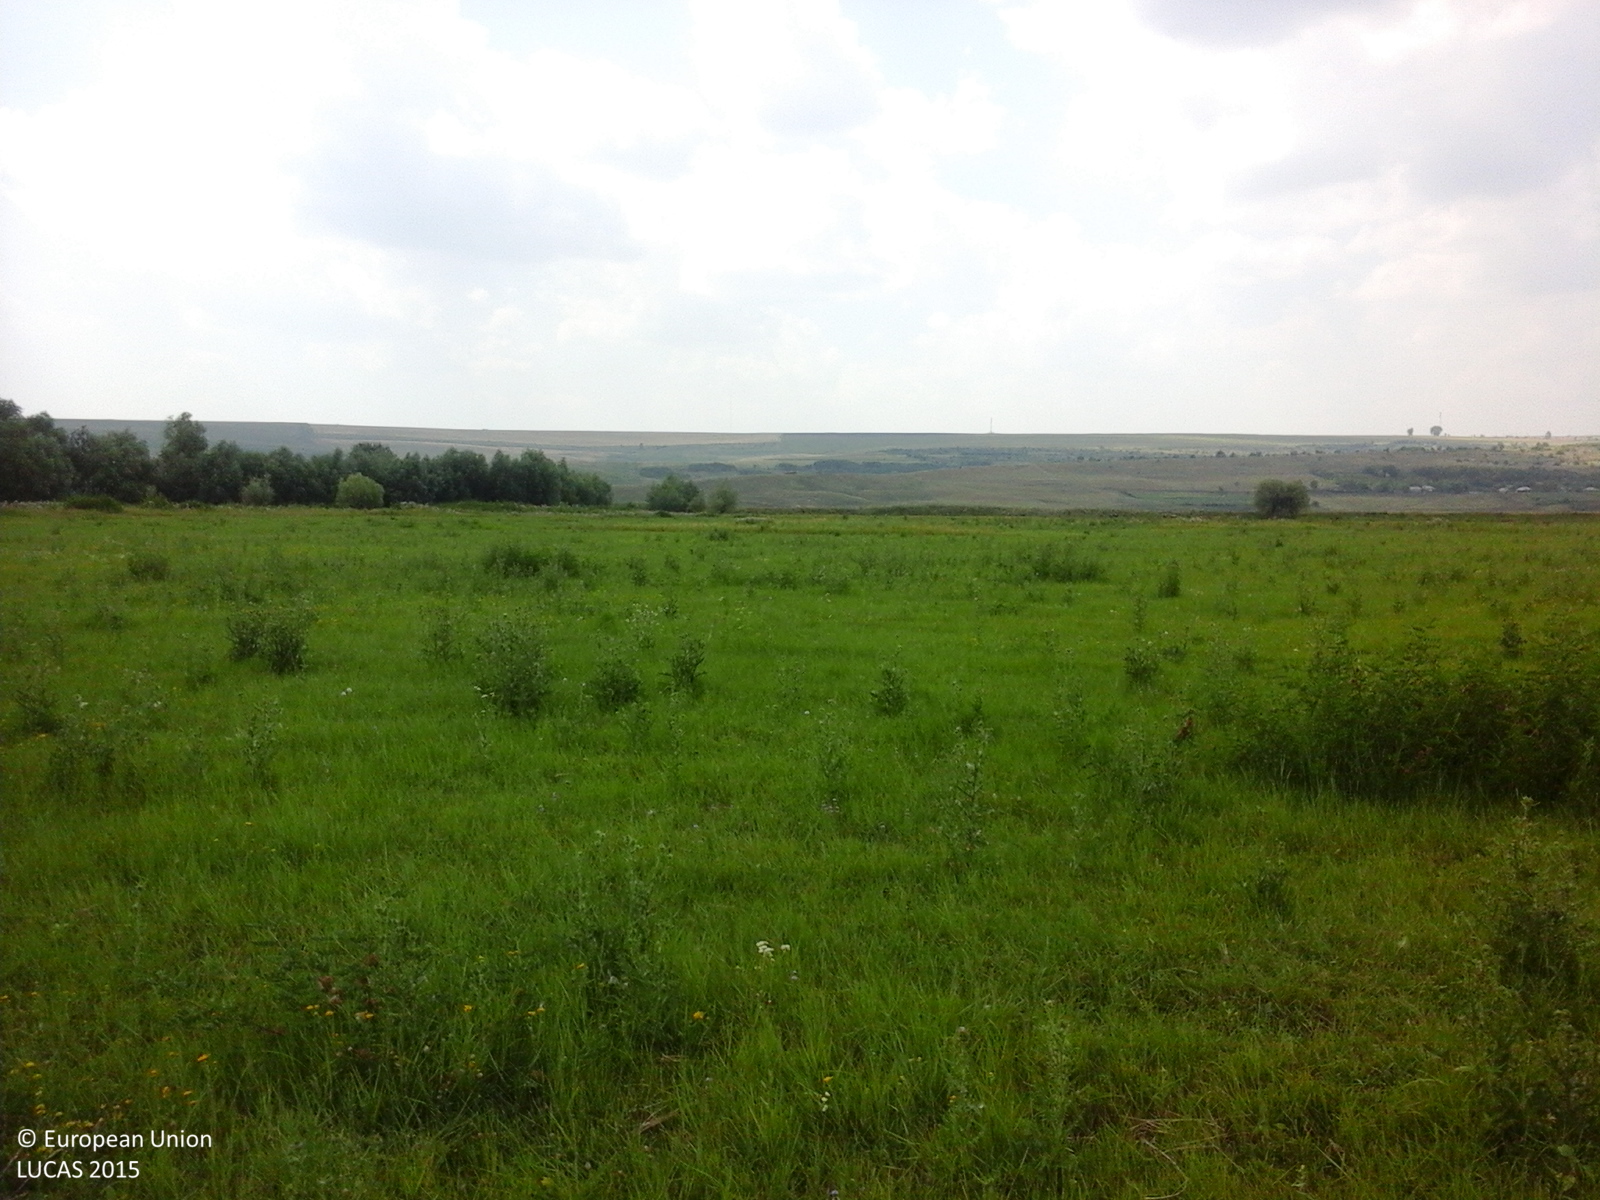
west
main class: Grassland
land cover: Spontaneously vegetated surfaces
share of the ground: > 75 %
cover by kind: herbaceous plants 100 %
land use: Agriculture (excluding fallow land and kitchen gardens)
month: July
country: RO
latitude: 46.0441
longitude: 28.1013
